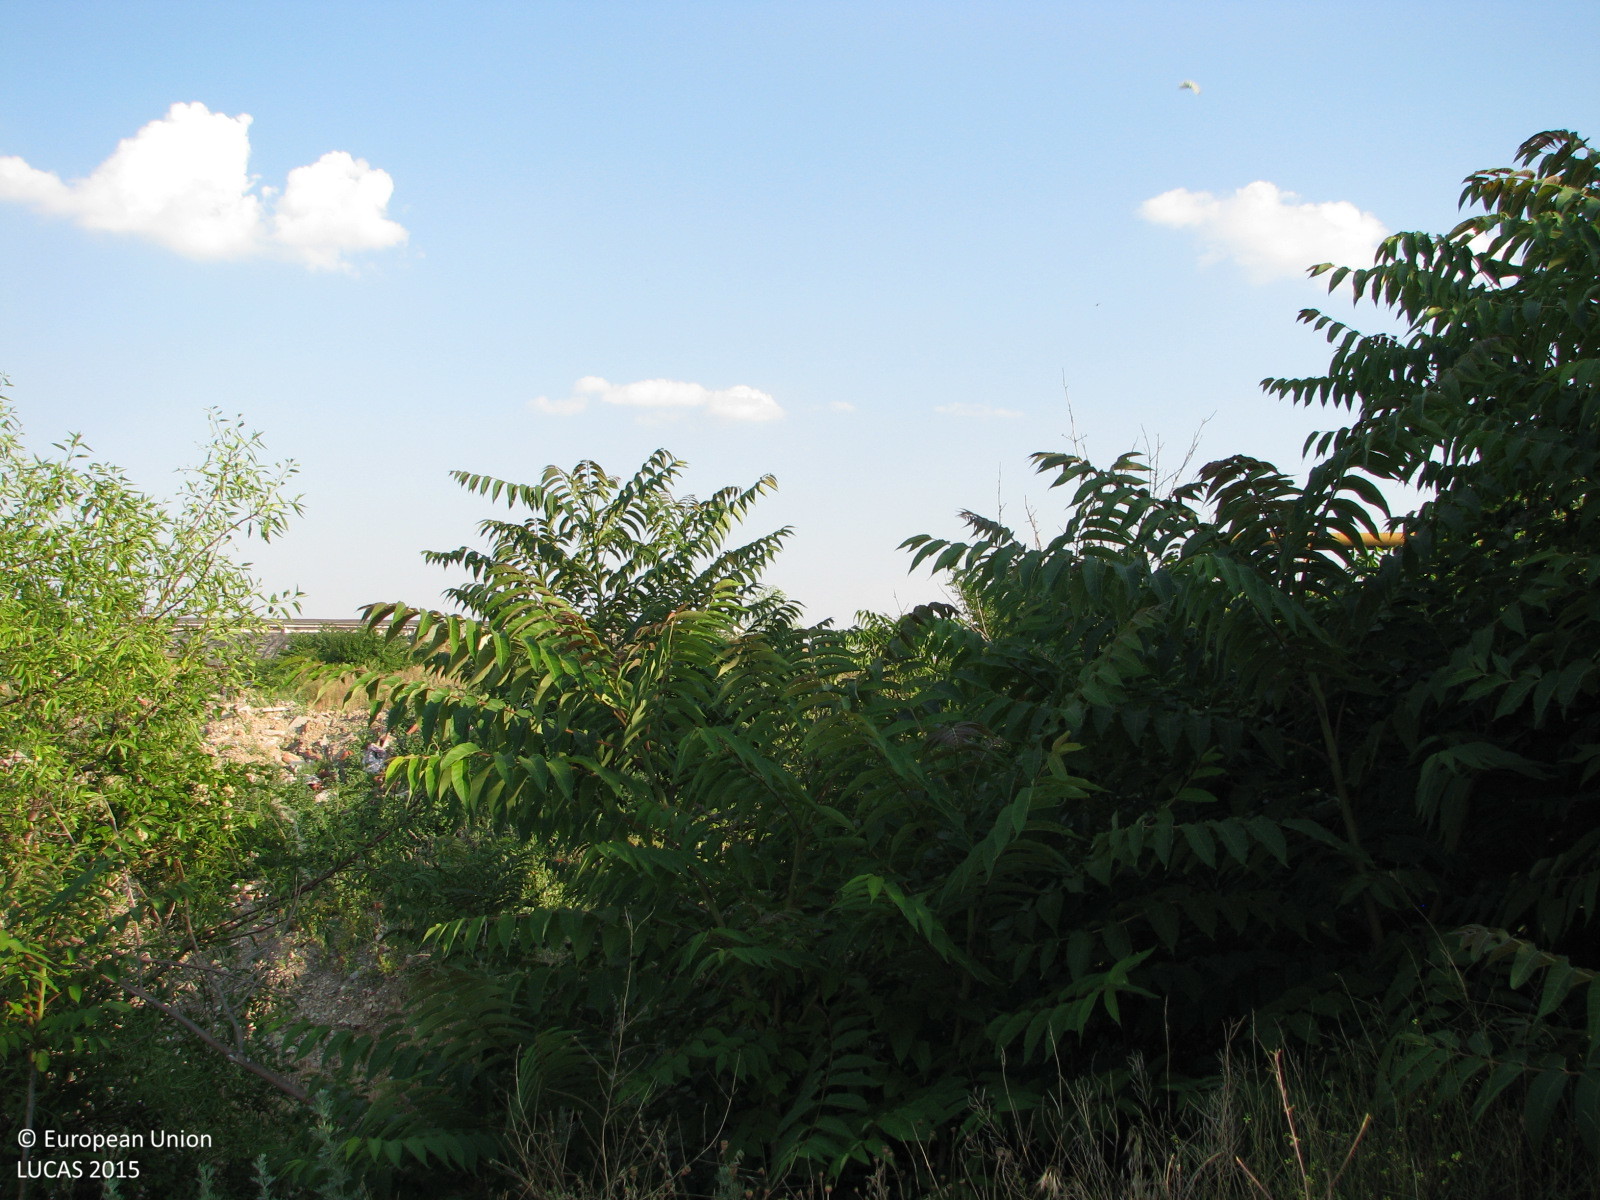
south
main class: Grassland
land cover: Grassland with sparse tree/shrub cover
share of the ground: > 75 %
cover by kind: herbaceous plants 90 %, broadleaved forest trees 5 %, shrubs 5 %
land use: Abandoned areas
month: June
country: BG
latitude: 42.6607
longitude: 26.3283
